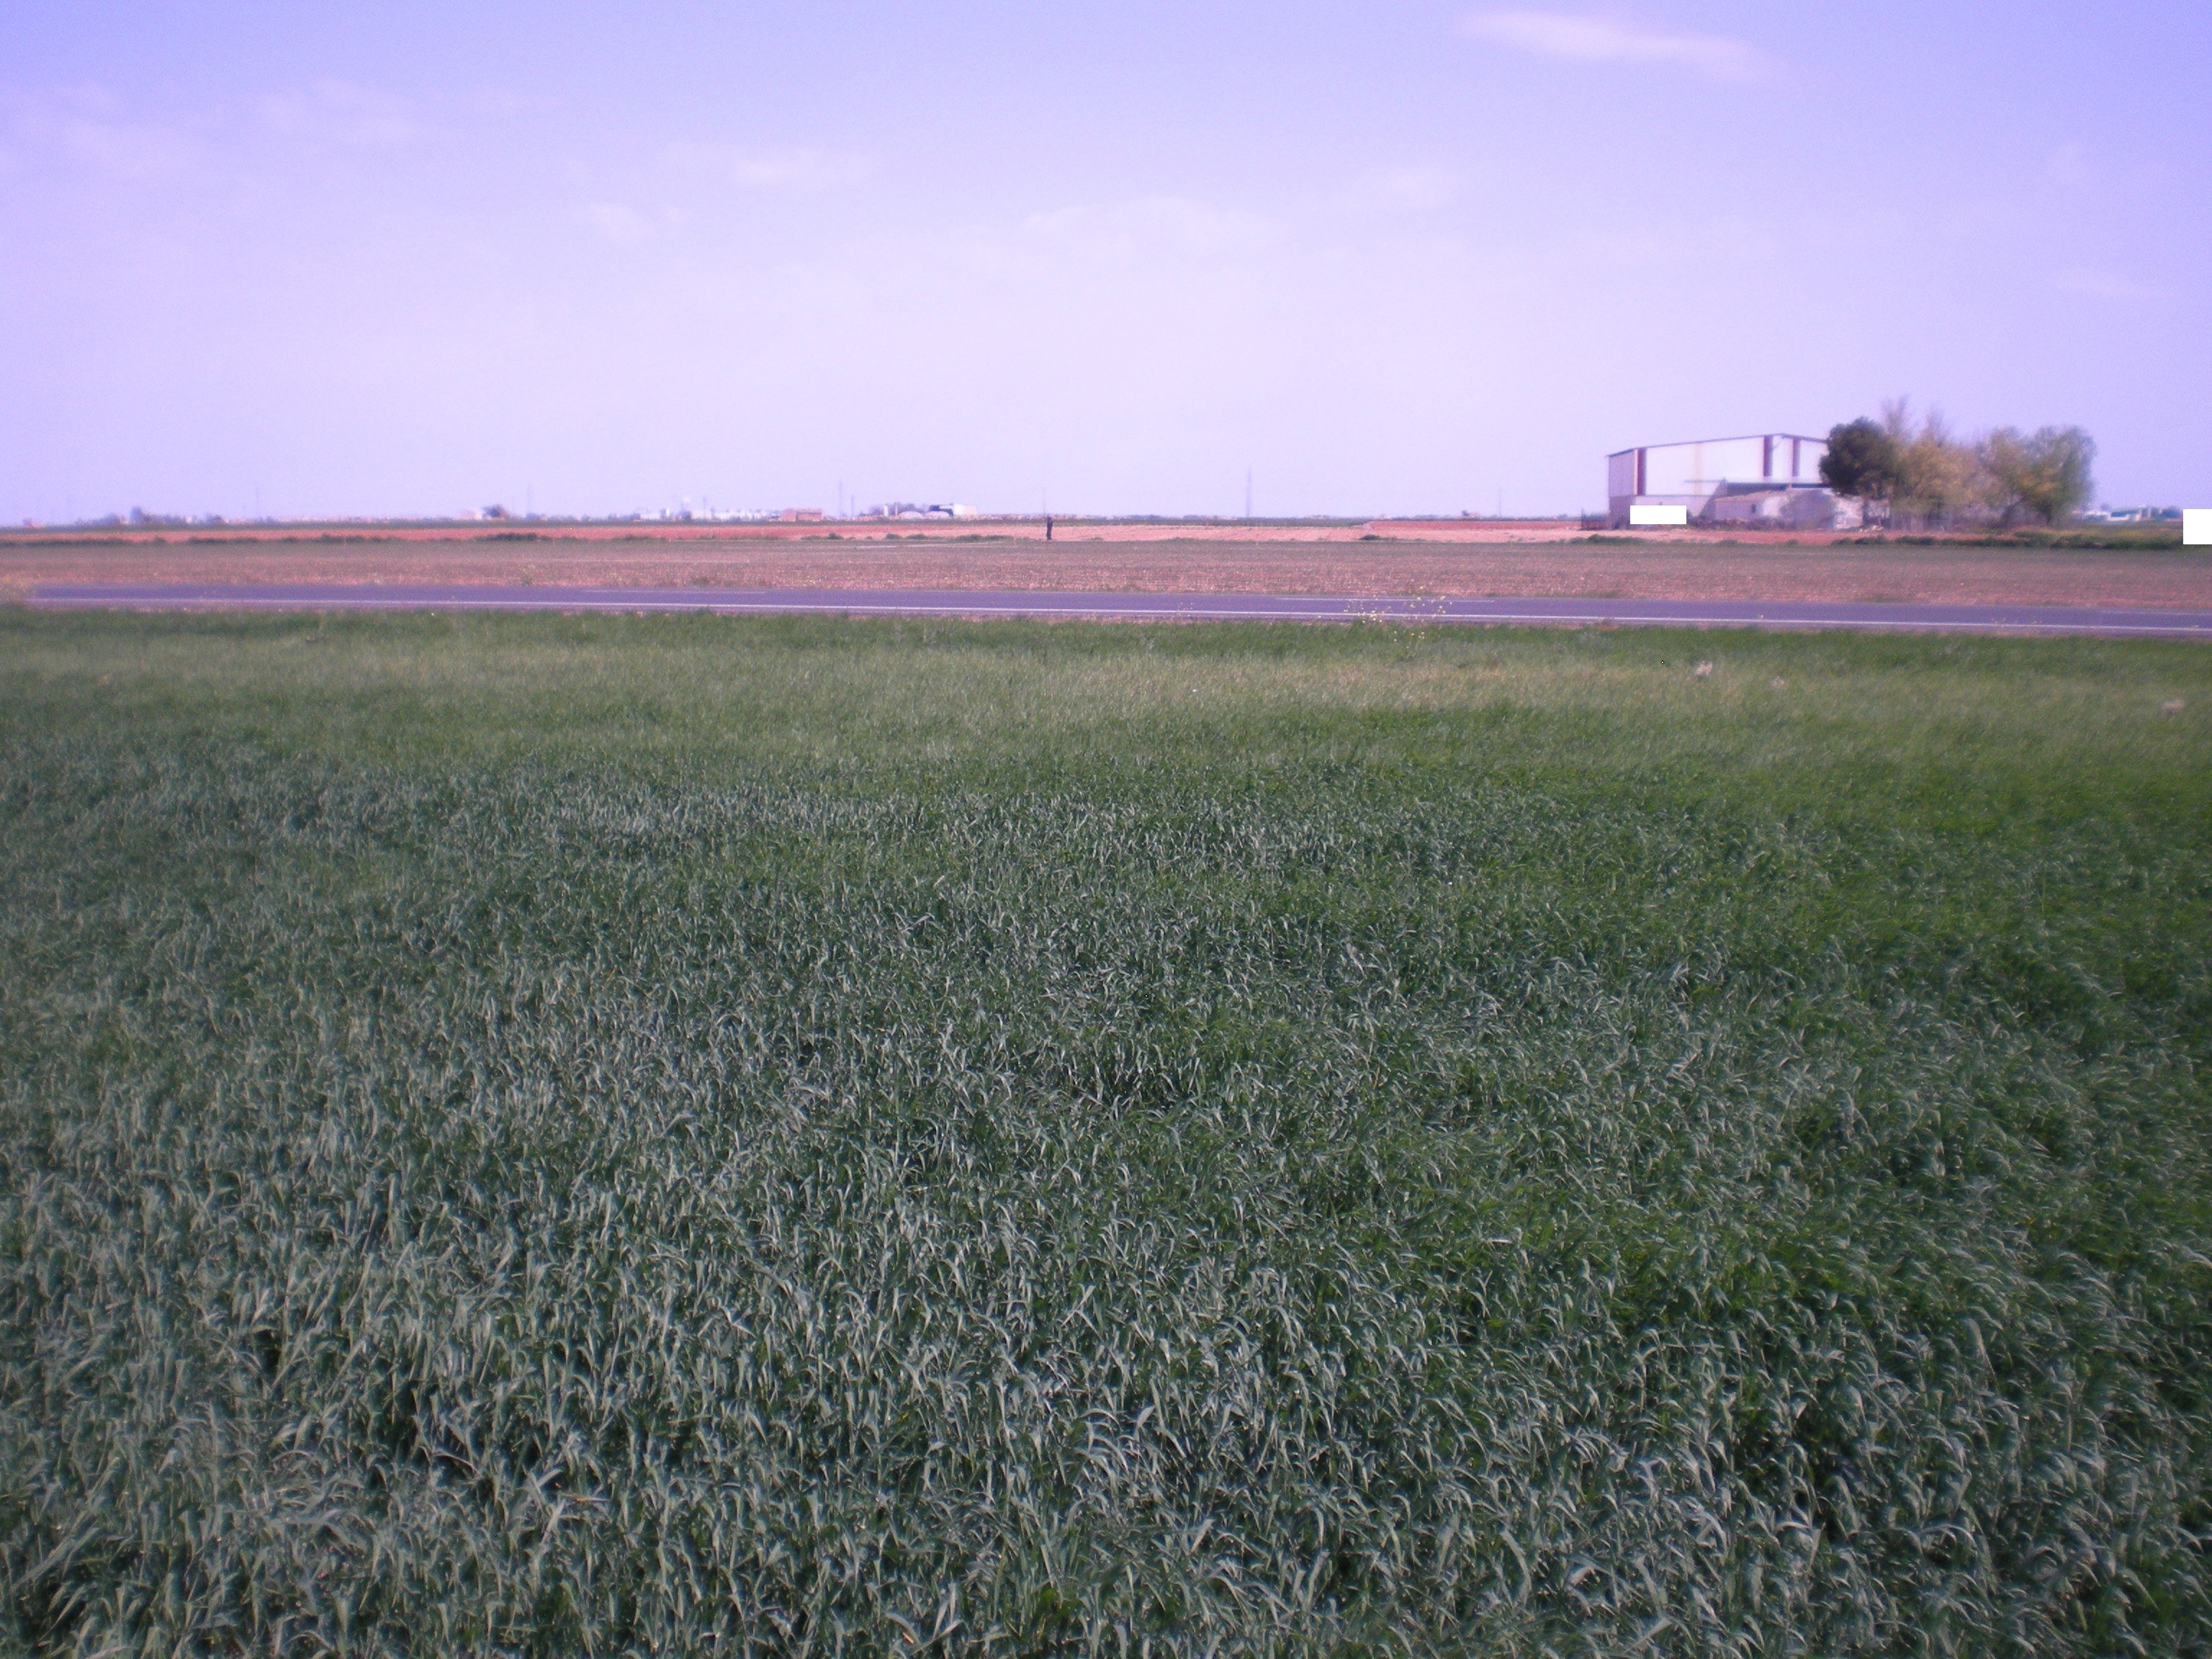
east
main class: Cropland
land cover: Barley
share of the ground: > 75 %
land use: Agriculture (excluding fallow land and kitchen gardens)
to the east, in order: Barley; Grass margins; Paved roads, cycling and walking lanes; Grass margins; Other fresh vegetables; Grass margins; Other bare soil
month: April
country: ES
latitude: 39.0174
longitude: -3.6343
